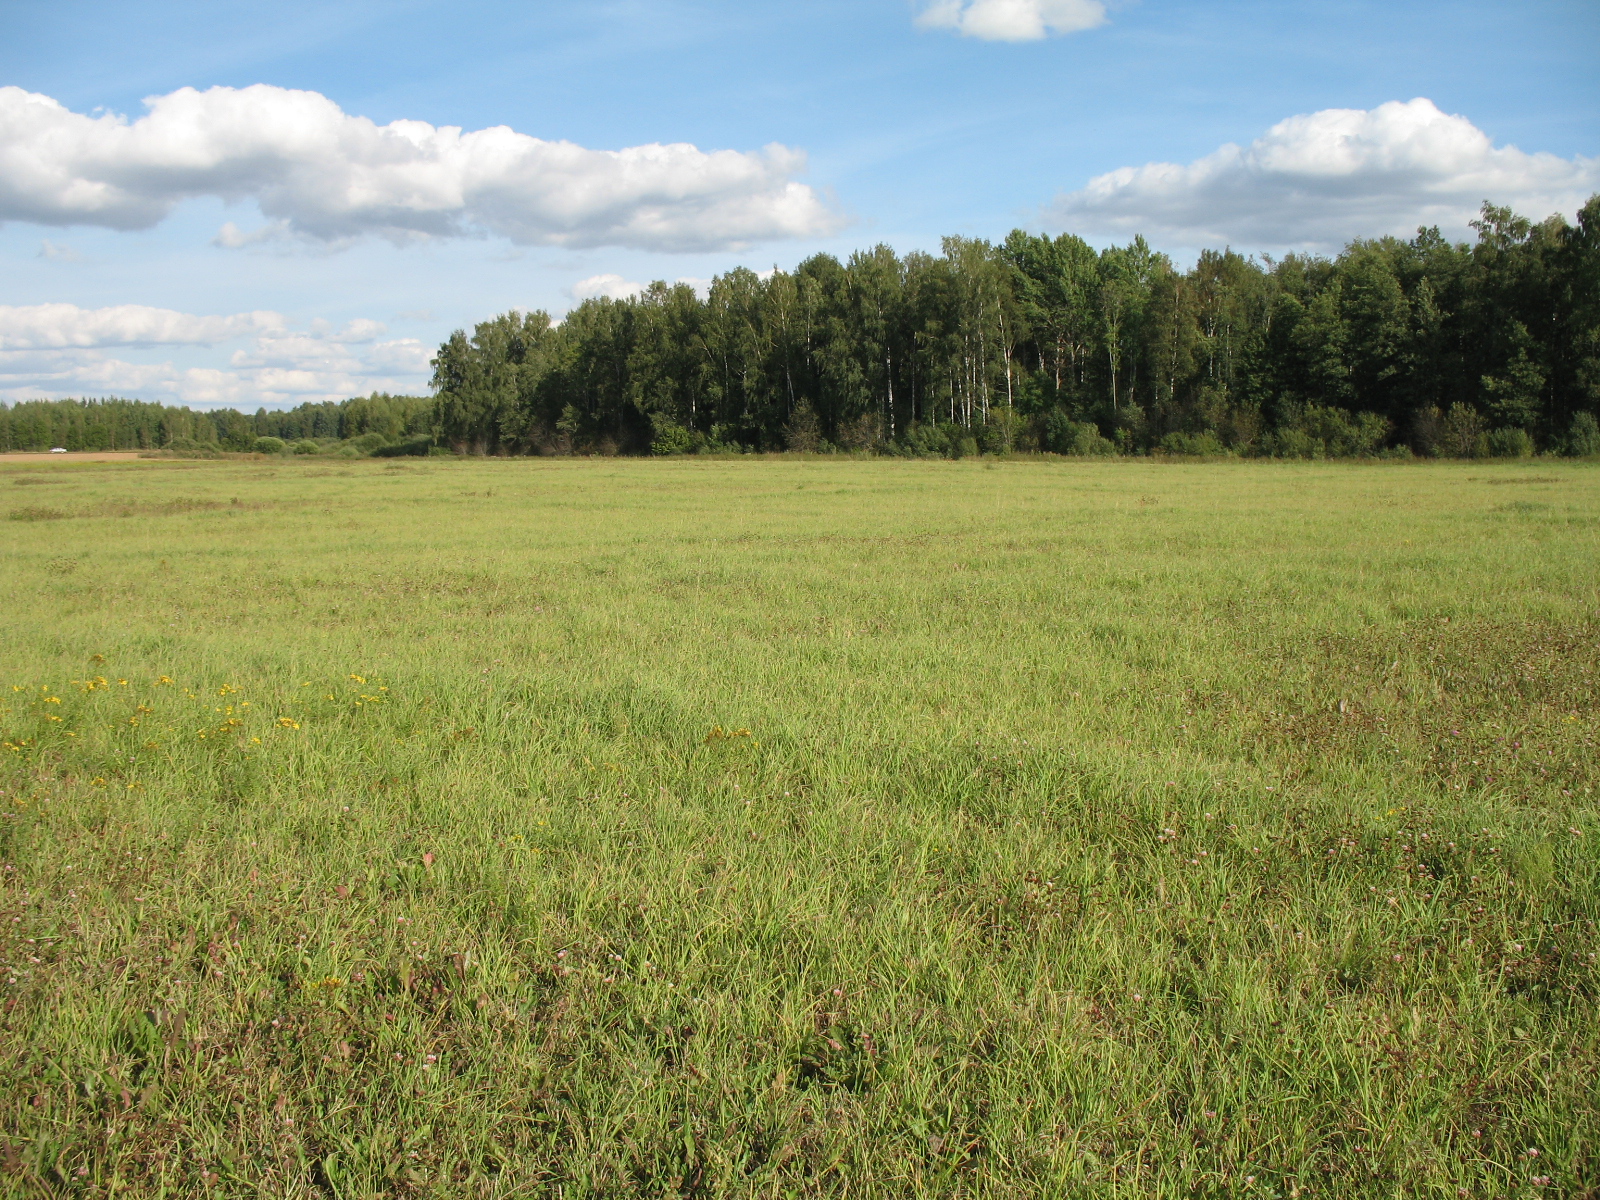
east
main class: Grassland
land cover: Grassland without tree/shrub cover
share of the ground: > 75 %
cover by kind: herbaceous plants 95 %, unconsolidated bare surface 5 %
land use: Agriculture (excluding fallow land and kitchen gardens)
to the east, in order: Grassland without tree/shrub cover; Spontaneously vegetated surfaces
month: August
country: LV
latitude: 56.2634
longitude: 26.1048
